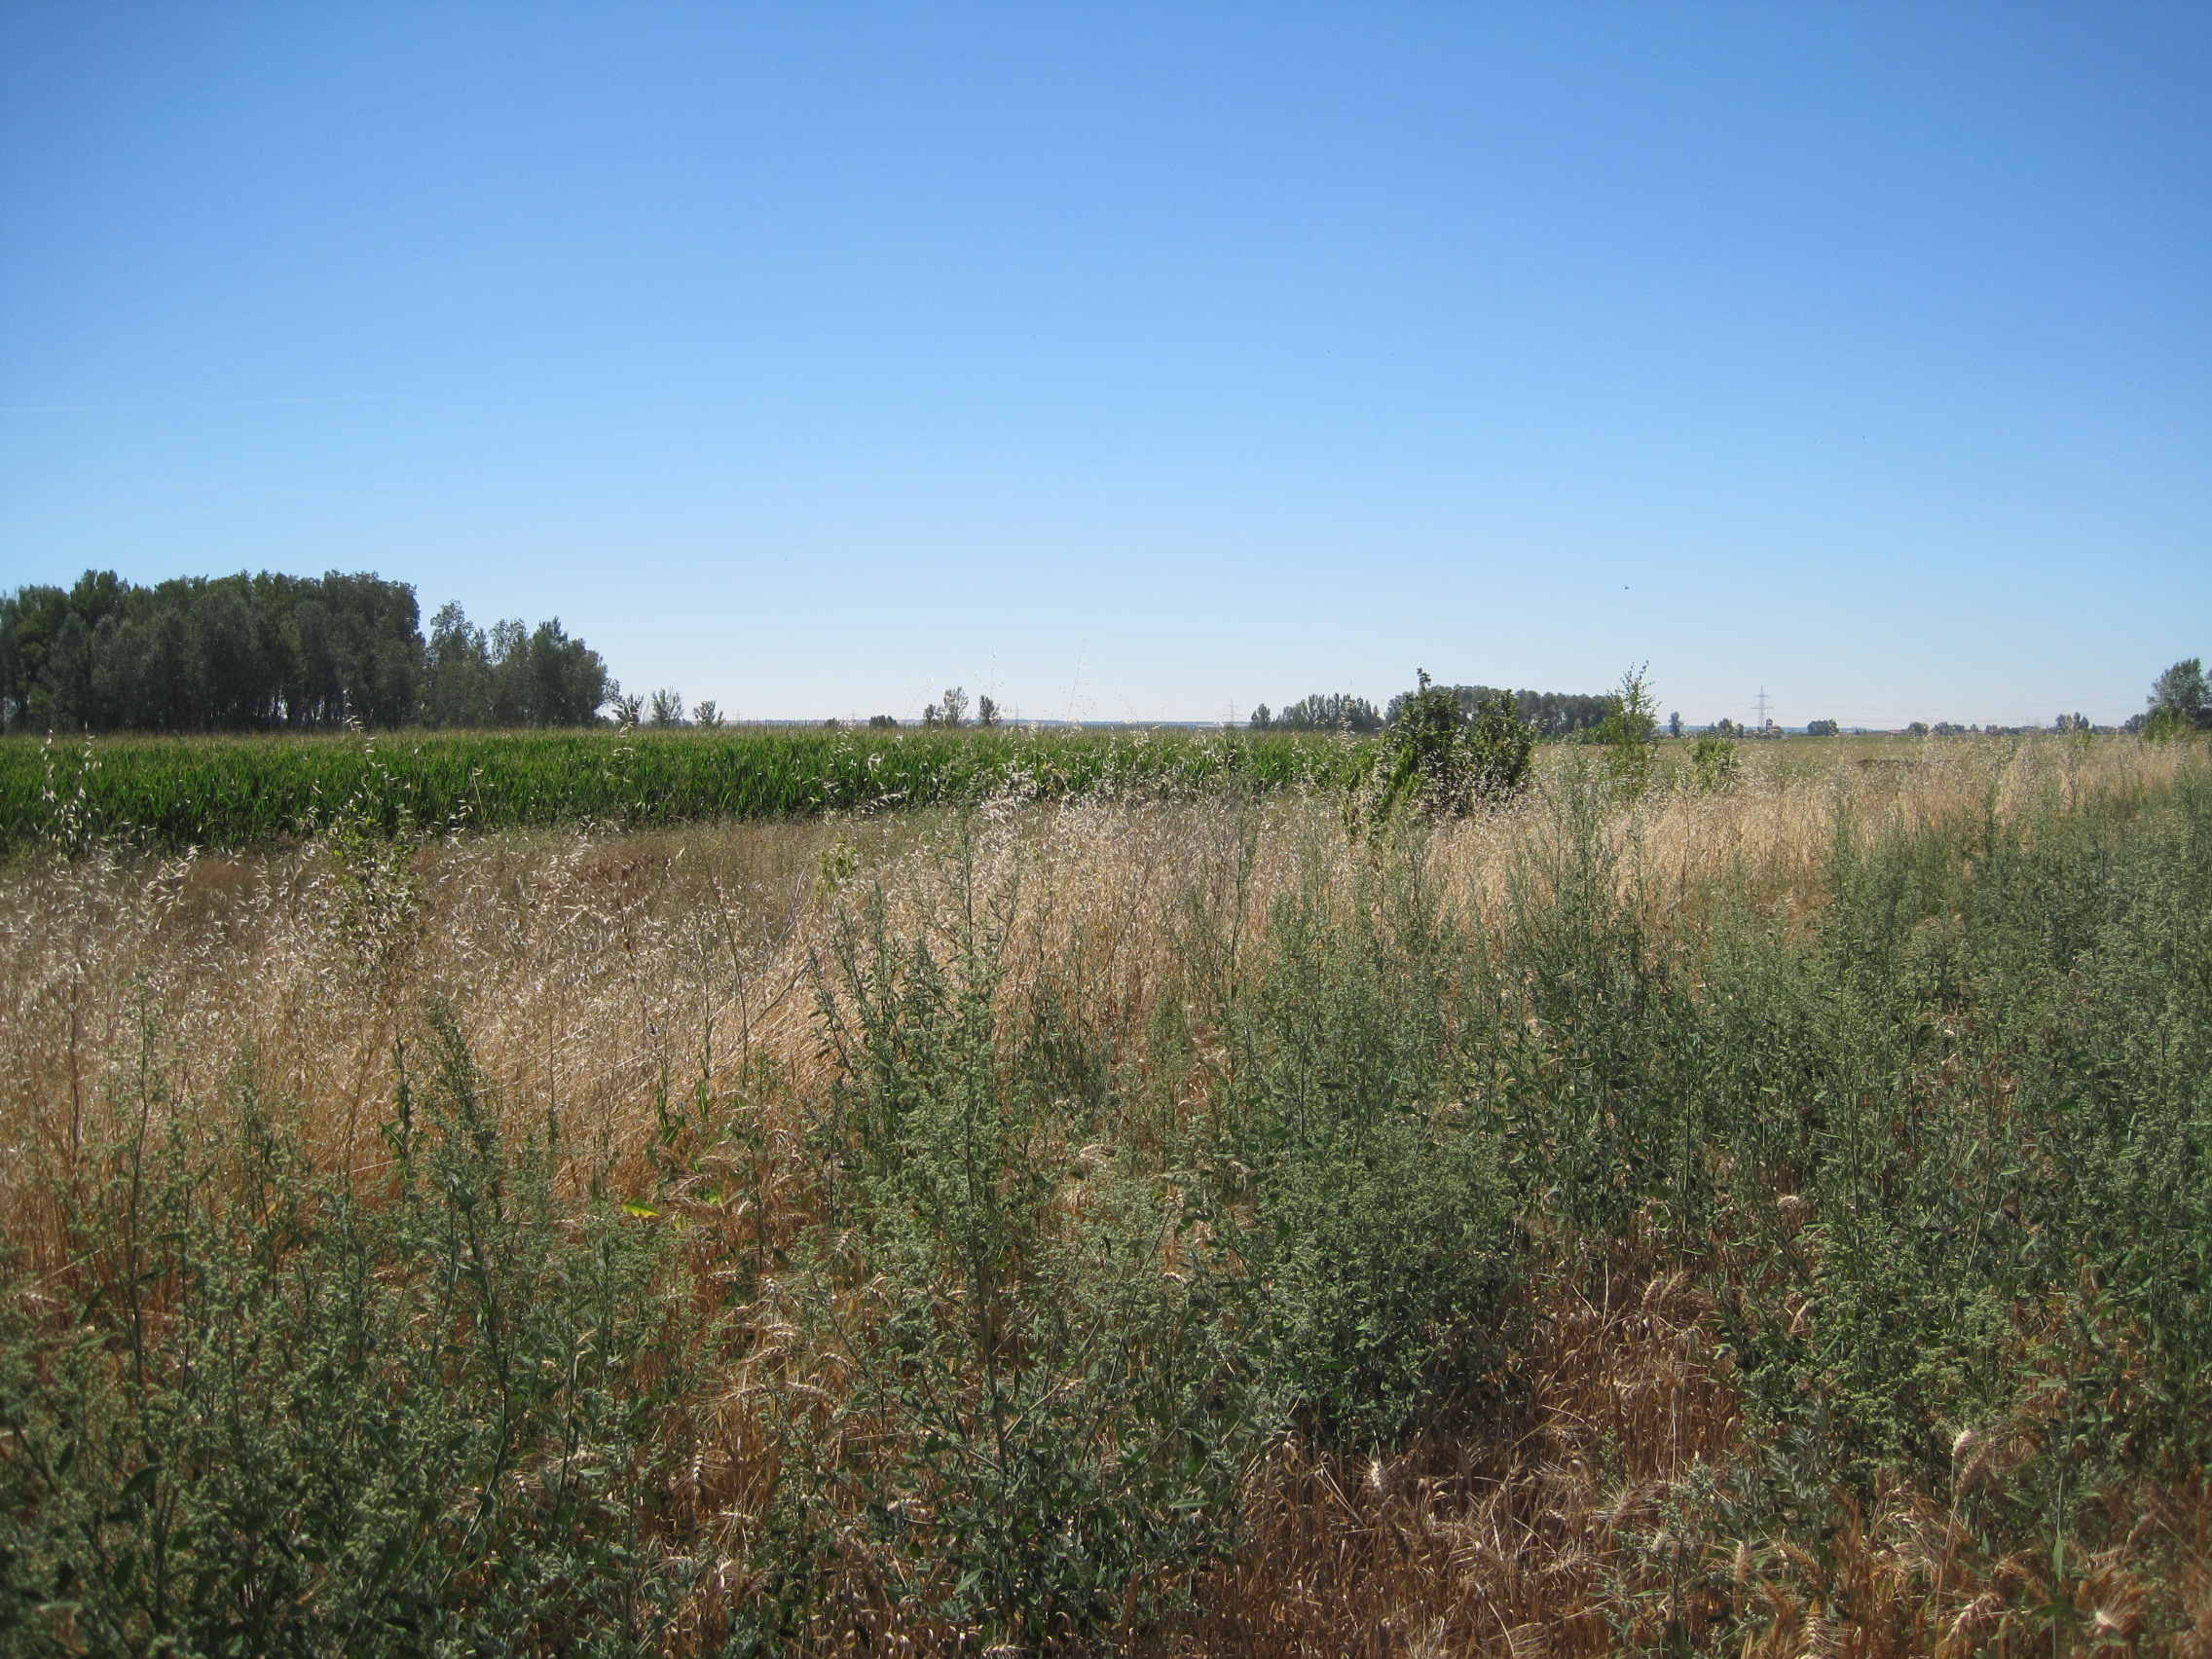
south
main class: Cropland
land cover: Common wheat
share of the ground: > 75 %
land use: Agriculture (excluding fallow land and kitchen gardens)
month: July
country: ES
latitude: 42.1711
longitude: -5.5992
